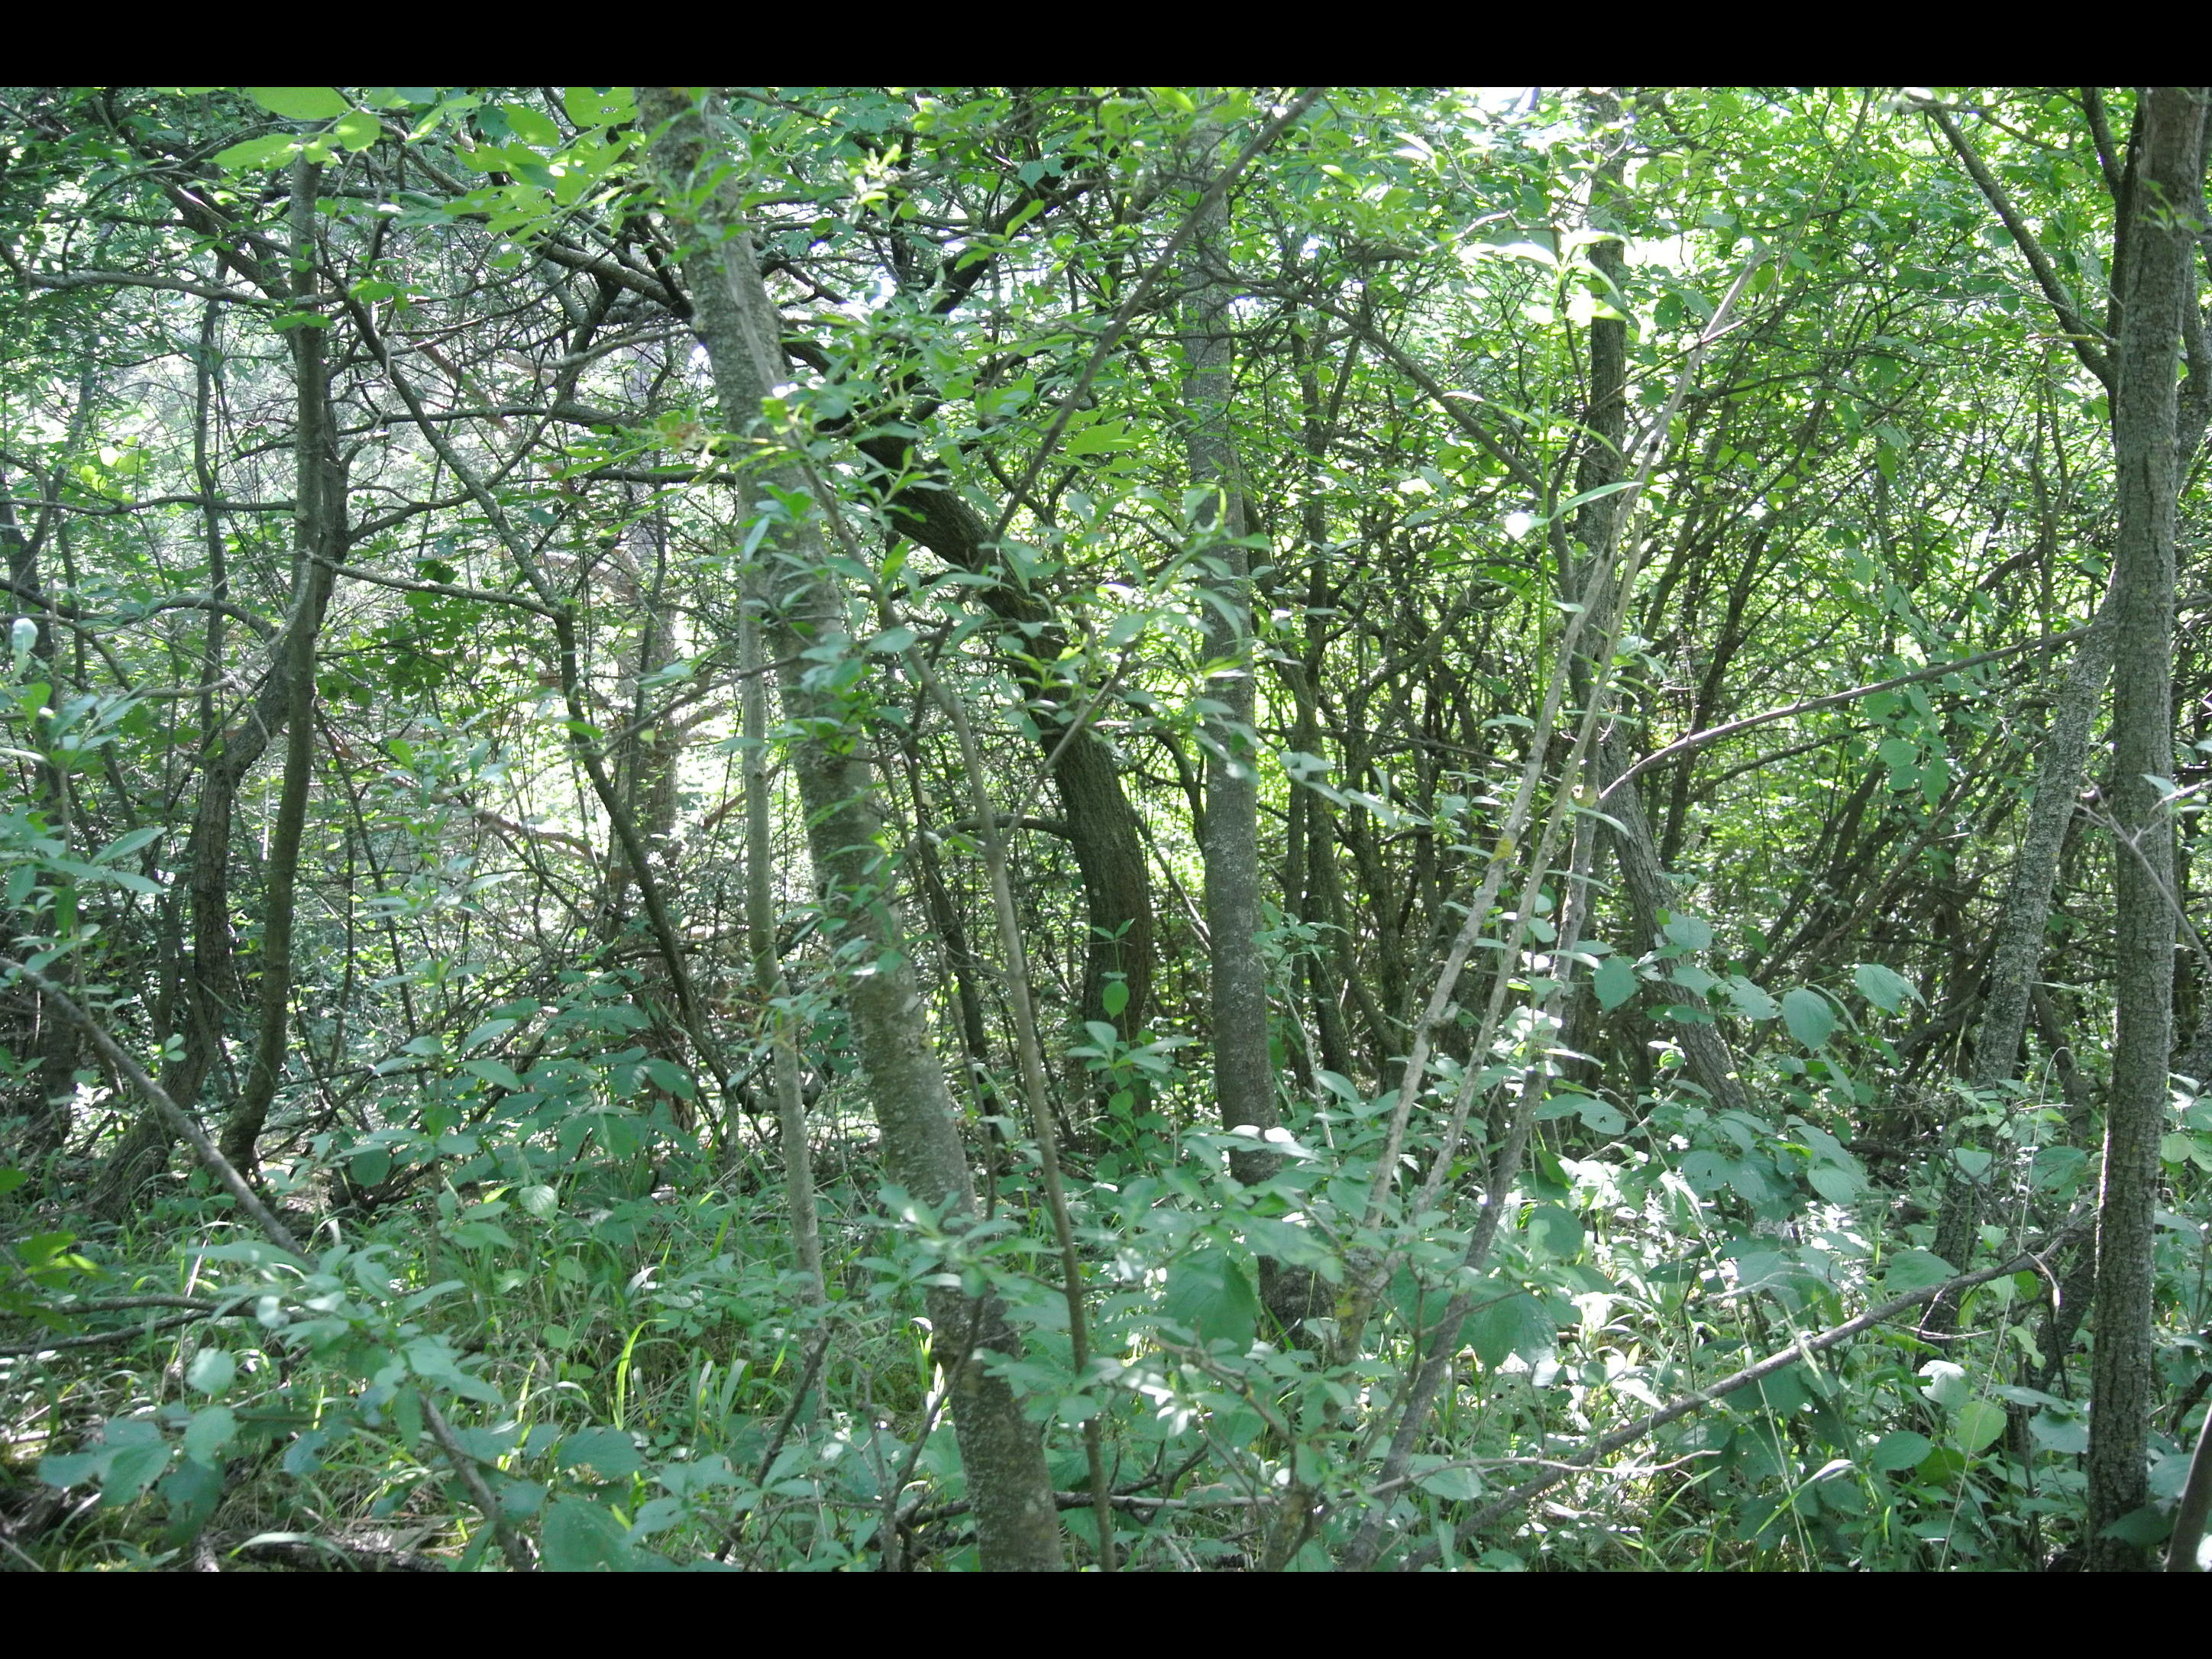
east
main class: Woodland
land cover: Broadleaved woodland
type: mesophytic deciduous forest
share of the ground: > 75 %
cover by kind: broadleaved forest trees 90 %, herbaceous plants 10 %
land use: Forestry
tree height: > 5 m
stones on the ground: 10 - 25 %
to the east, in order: Broadleaved woodland; Pine dominated mixed woodland; Shrubland with sparse tree cover; Pine dominated mixed woodland
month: June
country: AT
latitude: 47.8177
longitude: 16.4552
